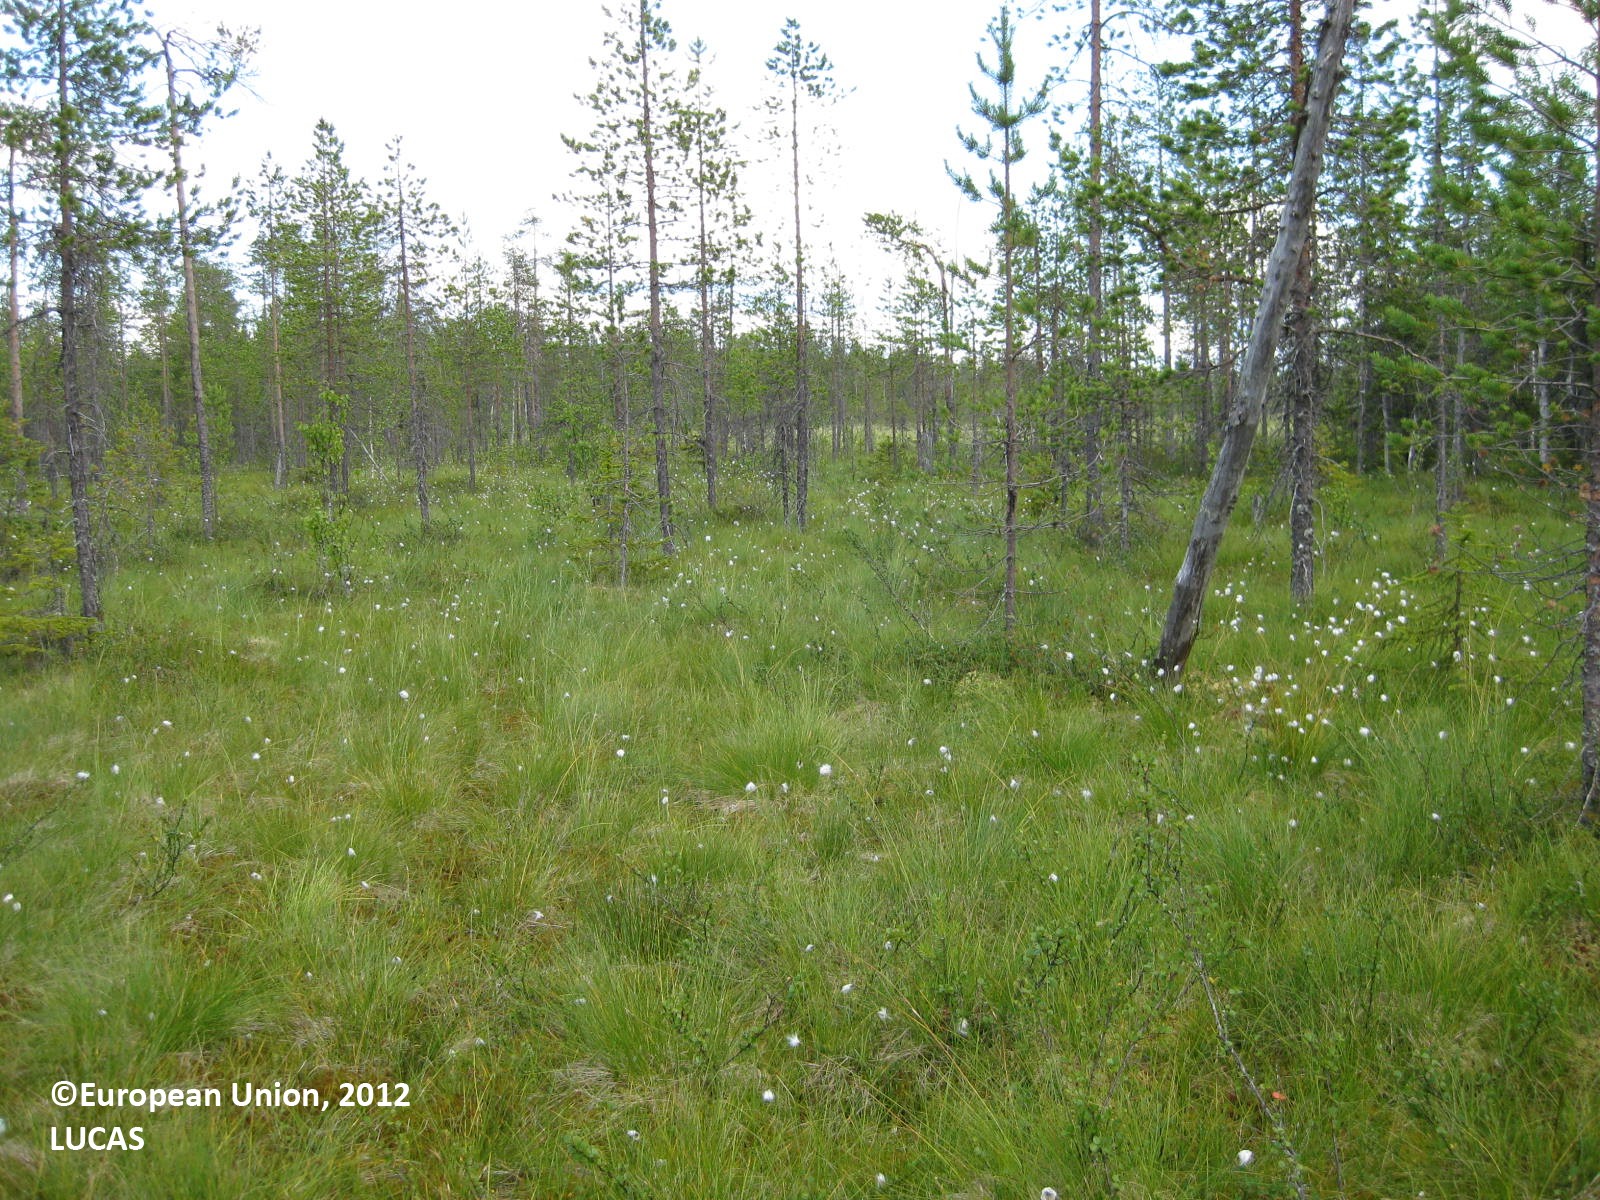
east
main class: Woodland
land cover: Pine dominated coniferous woodland
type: boreal forest
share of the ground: 25 - 50 %
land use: Semi-natural and natural areas not in use
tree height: > 5 m
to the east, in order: Pine dominated coniferous woodland; Peatbogs; Pine dominated coniferous woodland; Other mixed woodland; Pine dominated mixed woodland
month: July
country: FI
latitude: 65.7553
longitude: 28.5577
